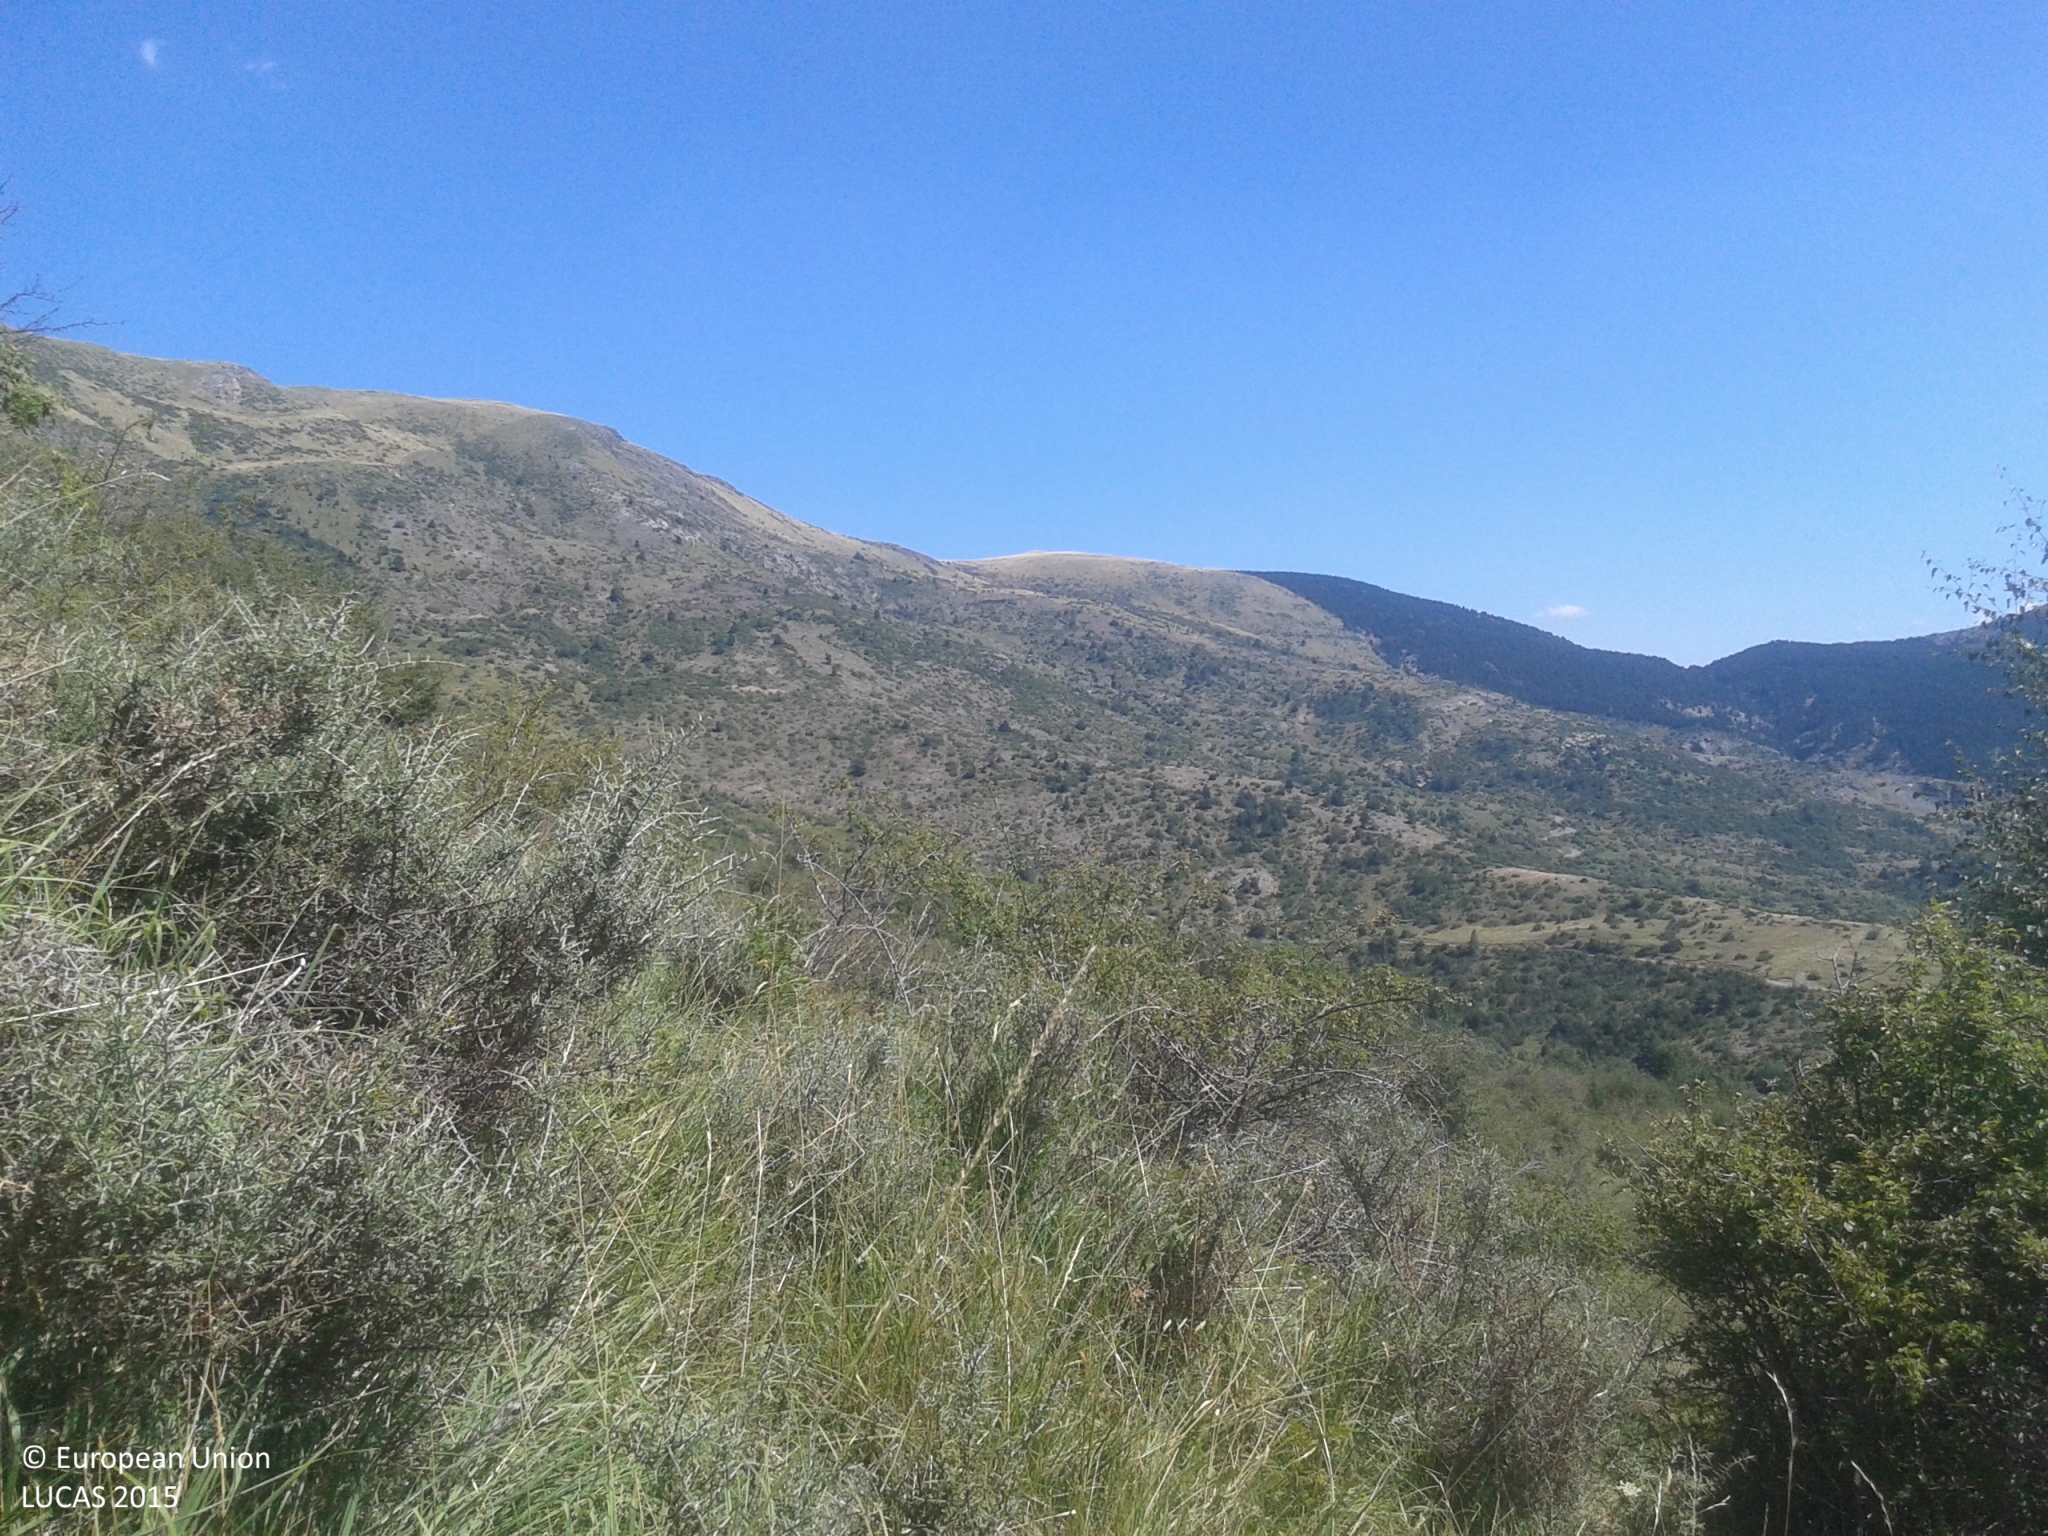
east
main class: Shrubland
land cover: Shrubland with sparse tree cover
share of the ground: 25 - 50 %
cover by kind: herbaceous plants 60 %, shrubs 30 %, broadleaved forest trees 5 %, consolidated bare surface 5 %
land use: Agriculture (excluding fallow land and kitchen gardens)
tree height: > 5 m
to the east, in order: Shrubland with sparse tree cover; Shrubland without tree cover; Grassland with sparse tree/shrub cover; Tracks; Shrubland without tree cover
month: August
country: ES
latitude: 42.4164
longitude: 1.0029
